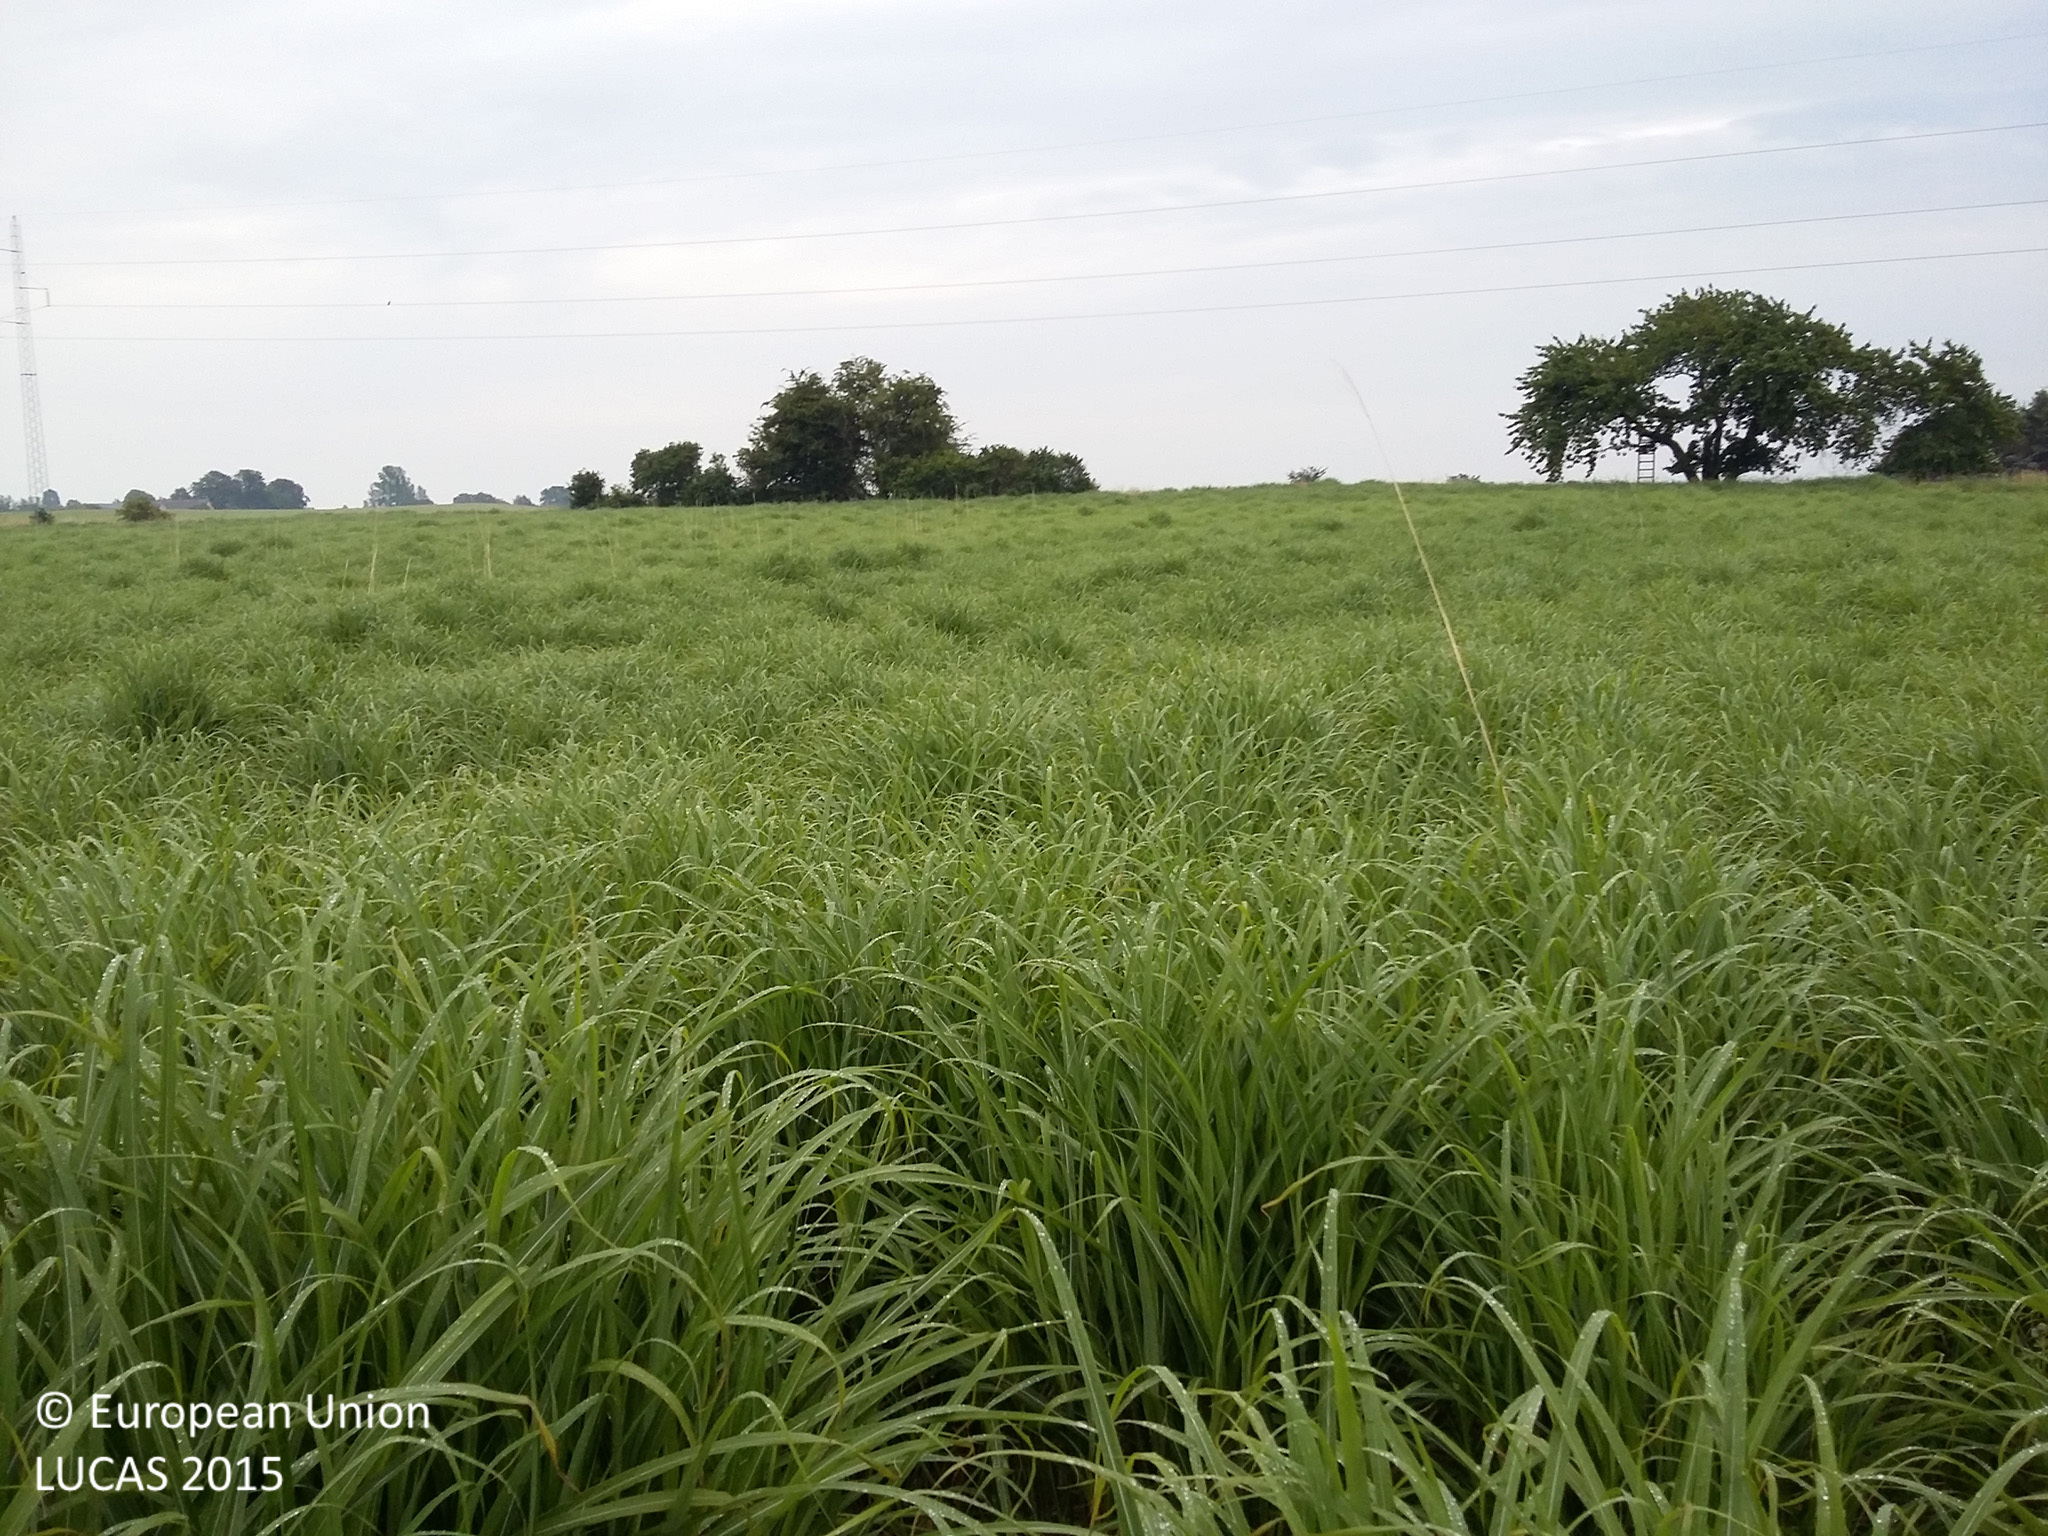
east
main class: Cropland
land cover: Permanent industrial crops
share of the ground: > 75 %
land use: Agriculture (excluding fallow land and kitchen gardens)
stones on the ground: < 10 %
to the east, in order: Permanent industrial crops; Electric lines; Permanent industrial crops; Broadleaved woodland; Barley; Abandoned hedges; Common wheat
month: July
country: DK
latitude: 55.2974
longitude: 11.5580
